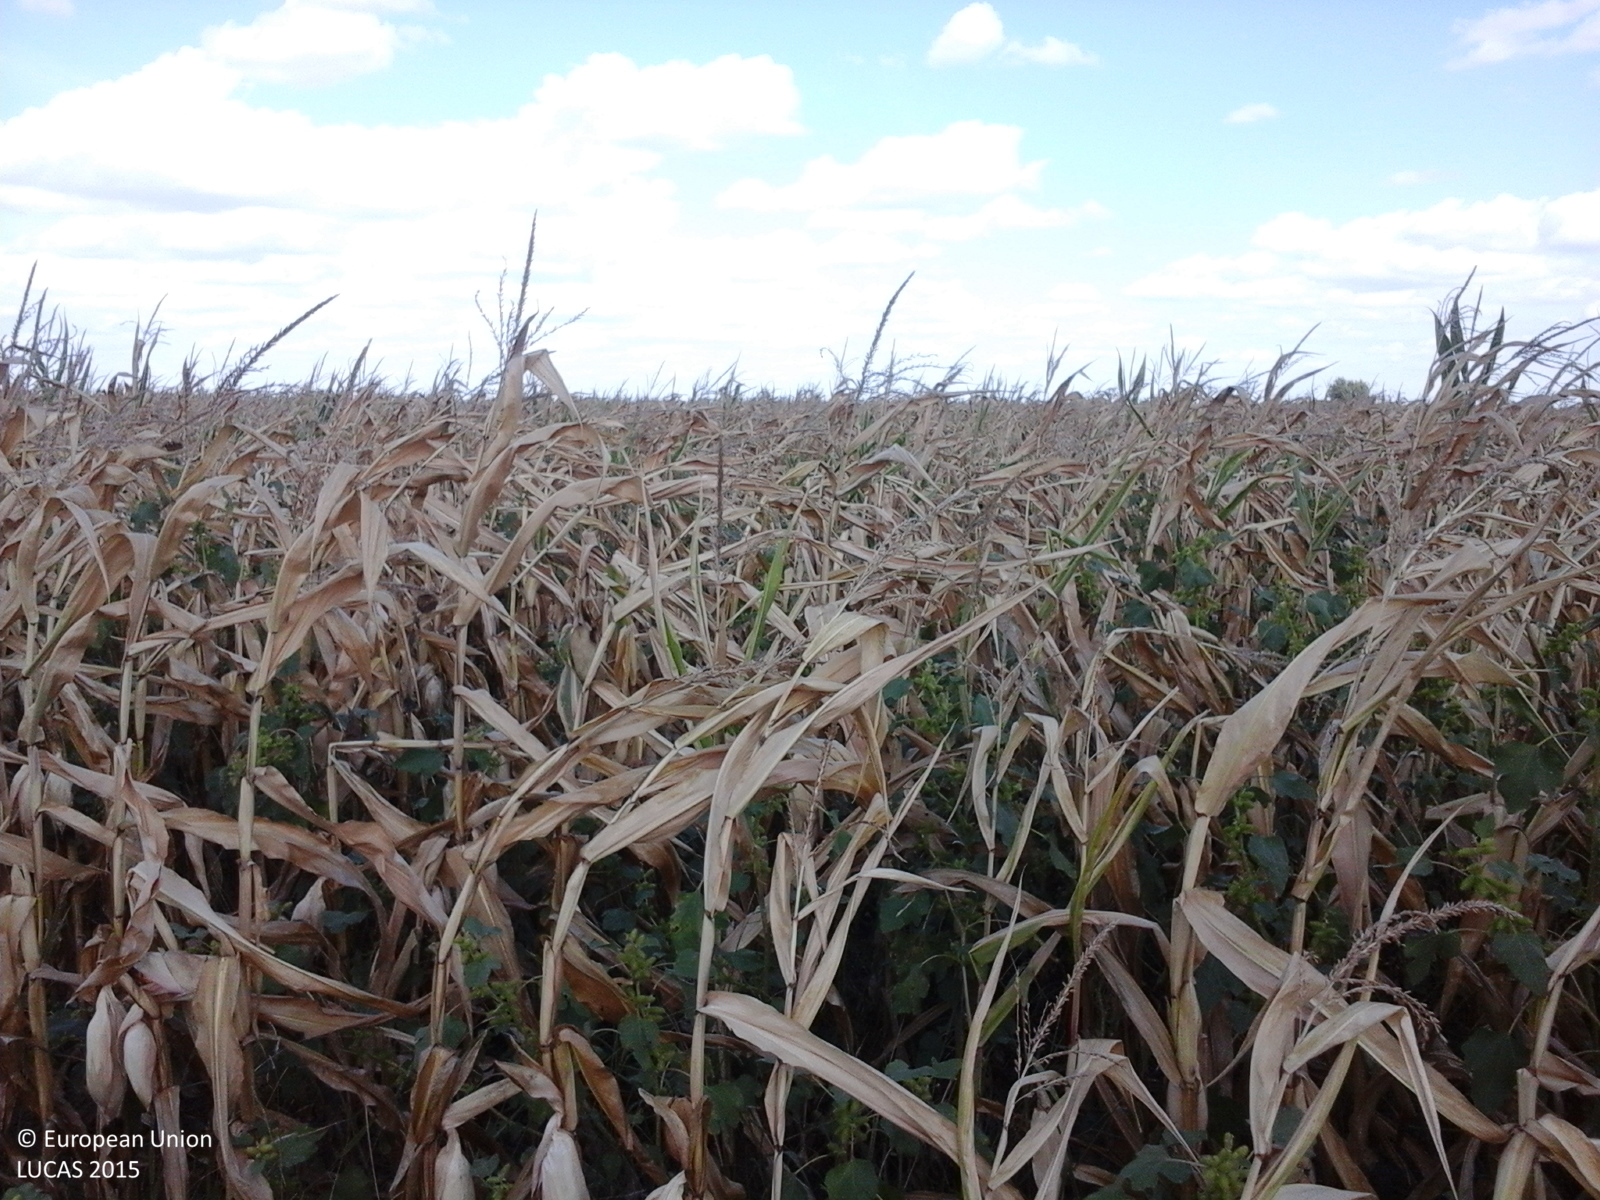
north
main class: Cropland
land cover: Maize
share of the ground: > 75 %
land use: Agriculture (excluding fallow land and kitchen gardens)
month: September
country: RO
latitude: 47.5823
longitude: 22.6511
